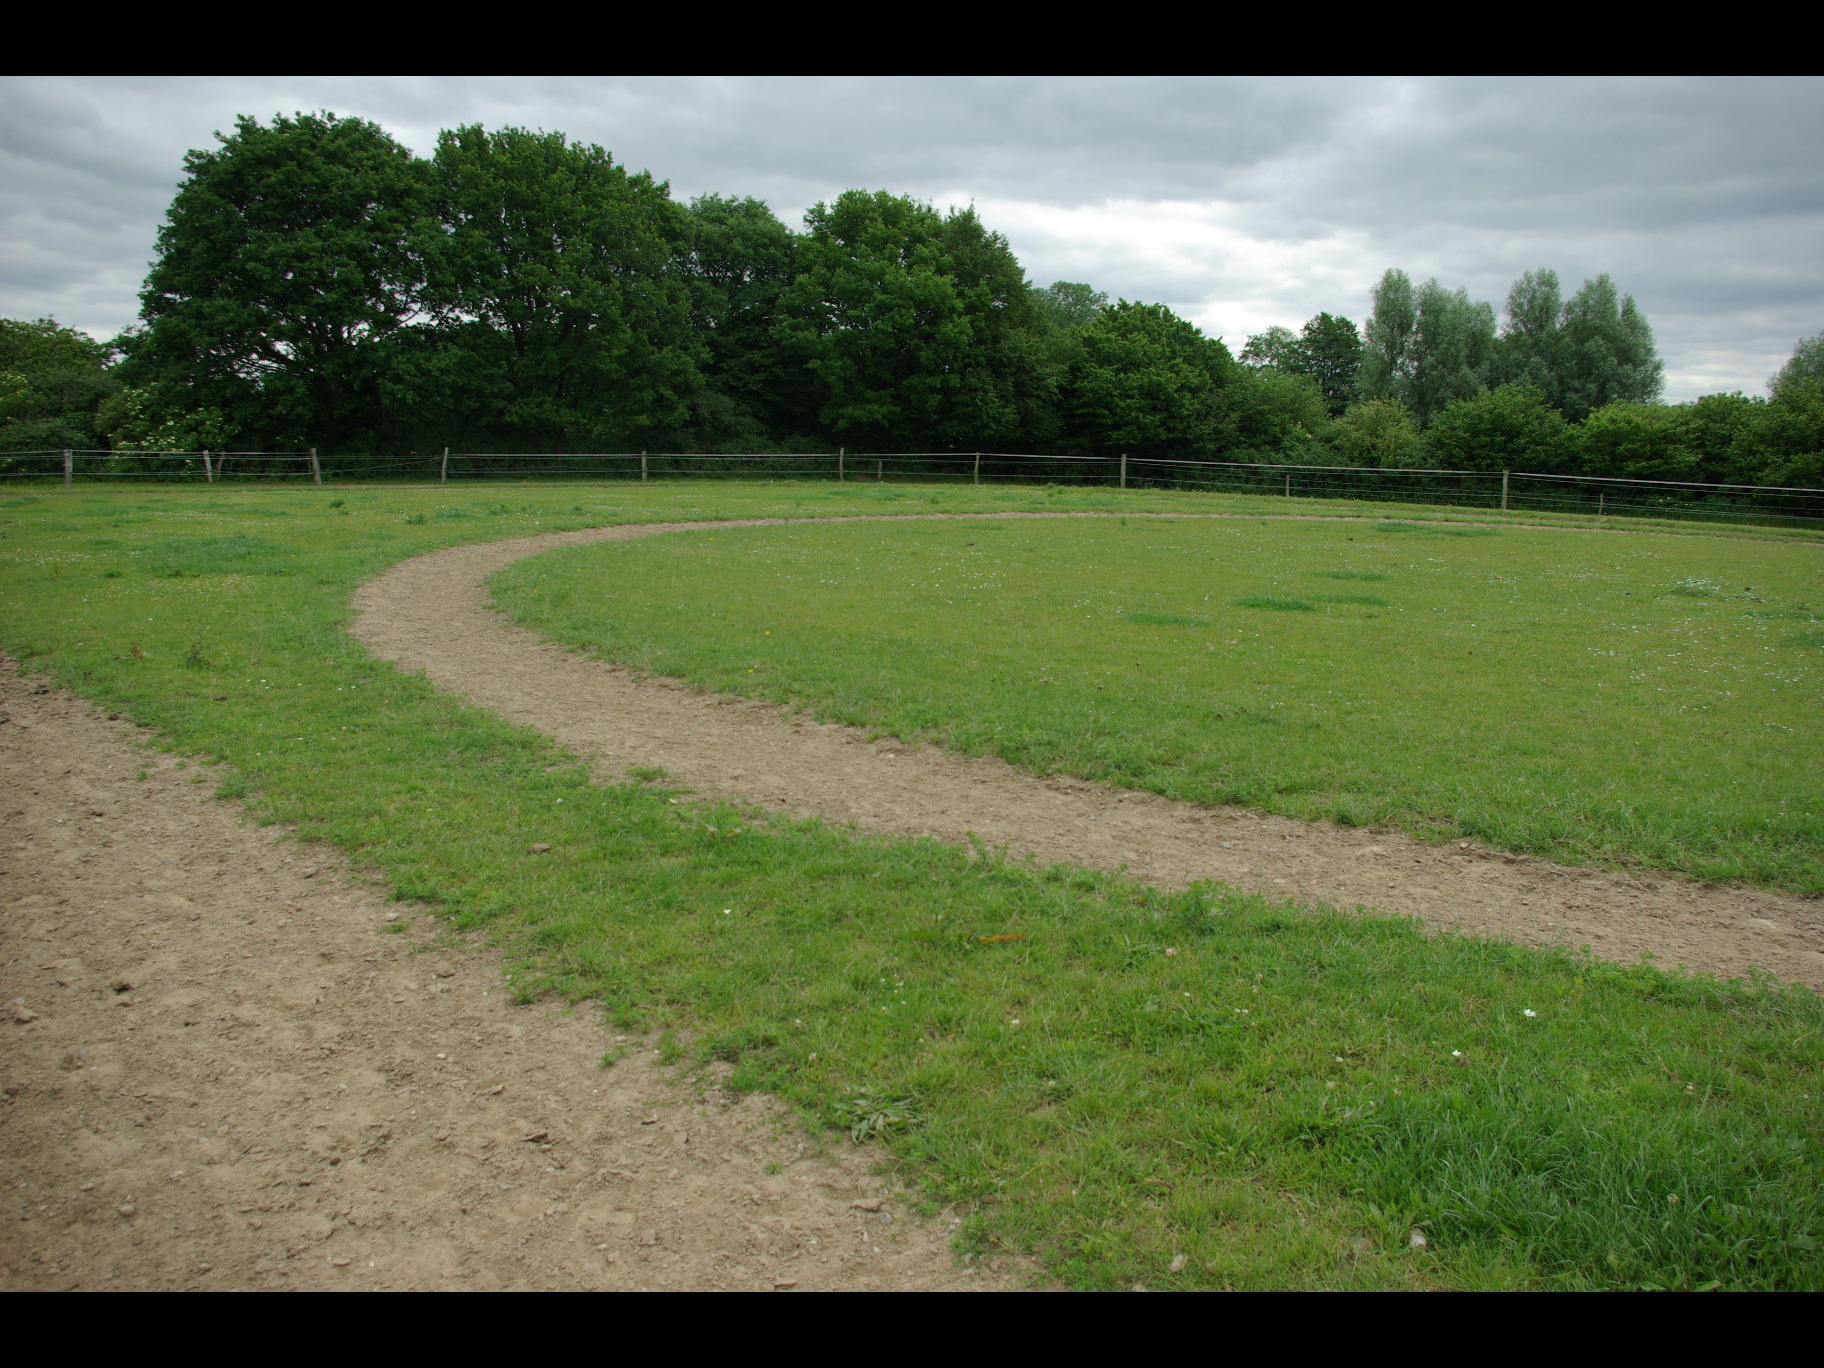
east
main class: Grassland
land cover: Grassland without tree/shrub cover
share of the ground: > 75 %
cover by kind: herbaceous plants 100 %
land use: Agriculture (excluding fallow land and kitchen gardens)
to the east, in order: Grassland without tree/shrub cover; Fences; Grass margins; Other bare soil; Grassland without tree/shrub cover; Other bare soil; Grass margins; Fences; Grassland without tree/shrub cover; Fences; Broadleaved woodland; Fences; Grassland without tree/shrub cover; Fences; Spontaneously vegetated surfaces; Inland fresh running water; Spontaneously vegetated surfaces; Inland fresh running water; Fences; Grassland without tree/shrub cover
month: June
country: DE
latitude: 54.0489
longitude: 9.8931
